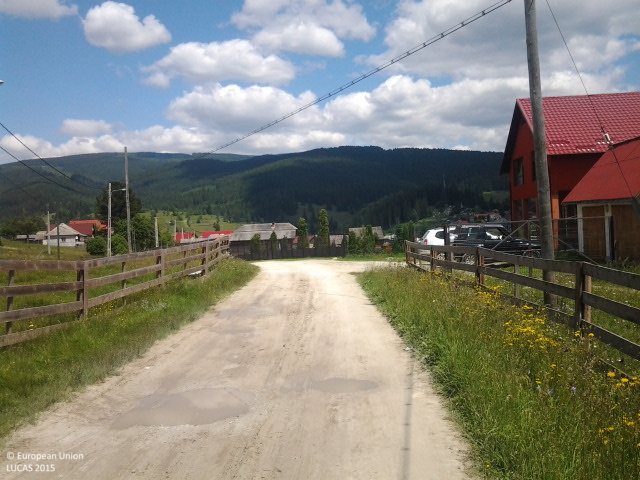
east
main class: Grassland
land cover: Grassland without tree/shrub cover
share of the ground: > 75 %
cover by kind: herbaceous plants 100 %
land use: Agriculture (excluding fallow land and kitchen gardens)
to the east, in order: Grassland without tree/shrub cover; Tracks; Grassland without tree/shrub cover; Abandoned hedges; Grassland without tree/shrub cover; Fences; Grassland without tree/shrub cover; Abandoned hedges; Ditches and canals; Arable land (only in case pi); Fences; Grassland without tree/shrub cover
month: June
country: RO
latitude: 47.0666
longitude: 25.4790
